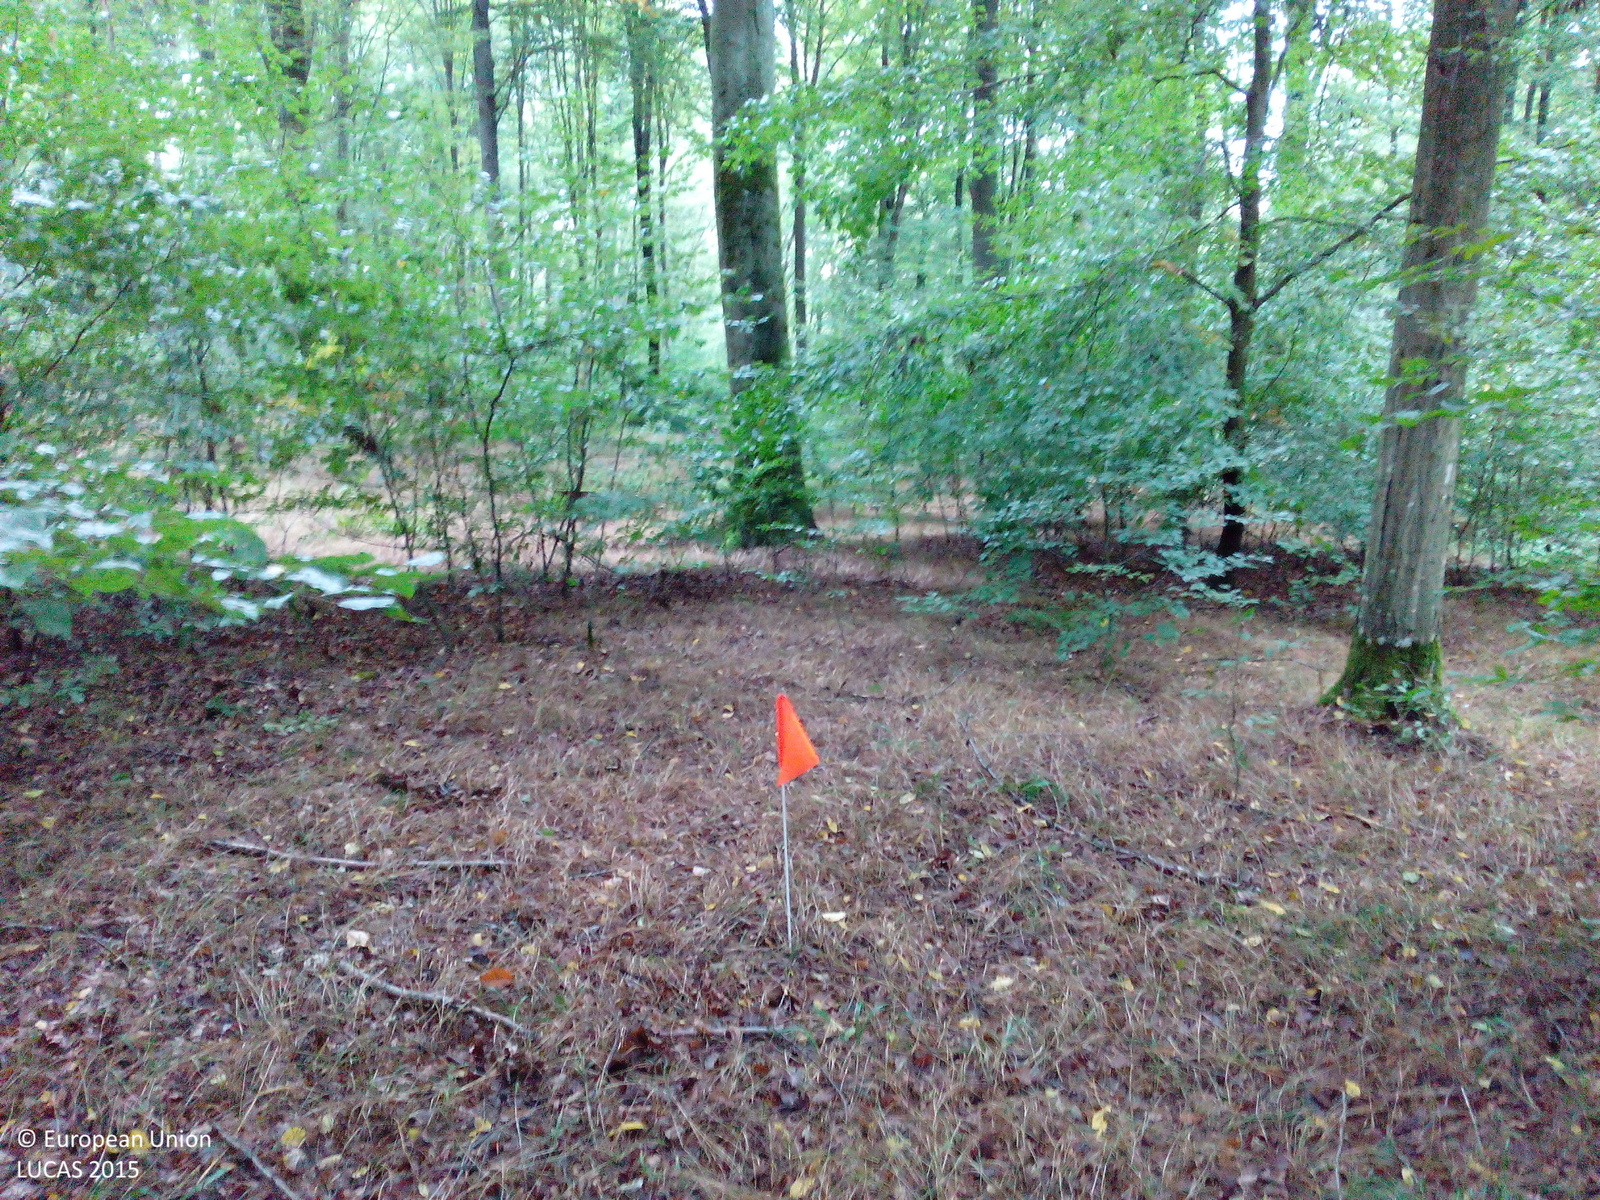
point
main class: Woodland
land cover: Broadleaved woodland
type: beech forest
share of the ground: > 75 %
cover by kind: broadleaved forest trees 95 %, herbaceous plants 5 %
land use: Forestry
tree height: > 5 m
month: September
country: DE
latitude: 49.9145
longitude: 9.9582
